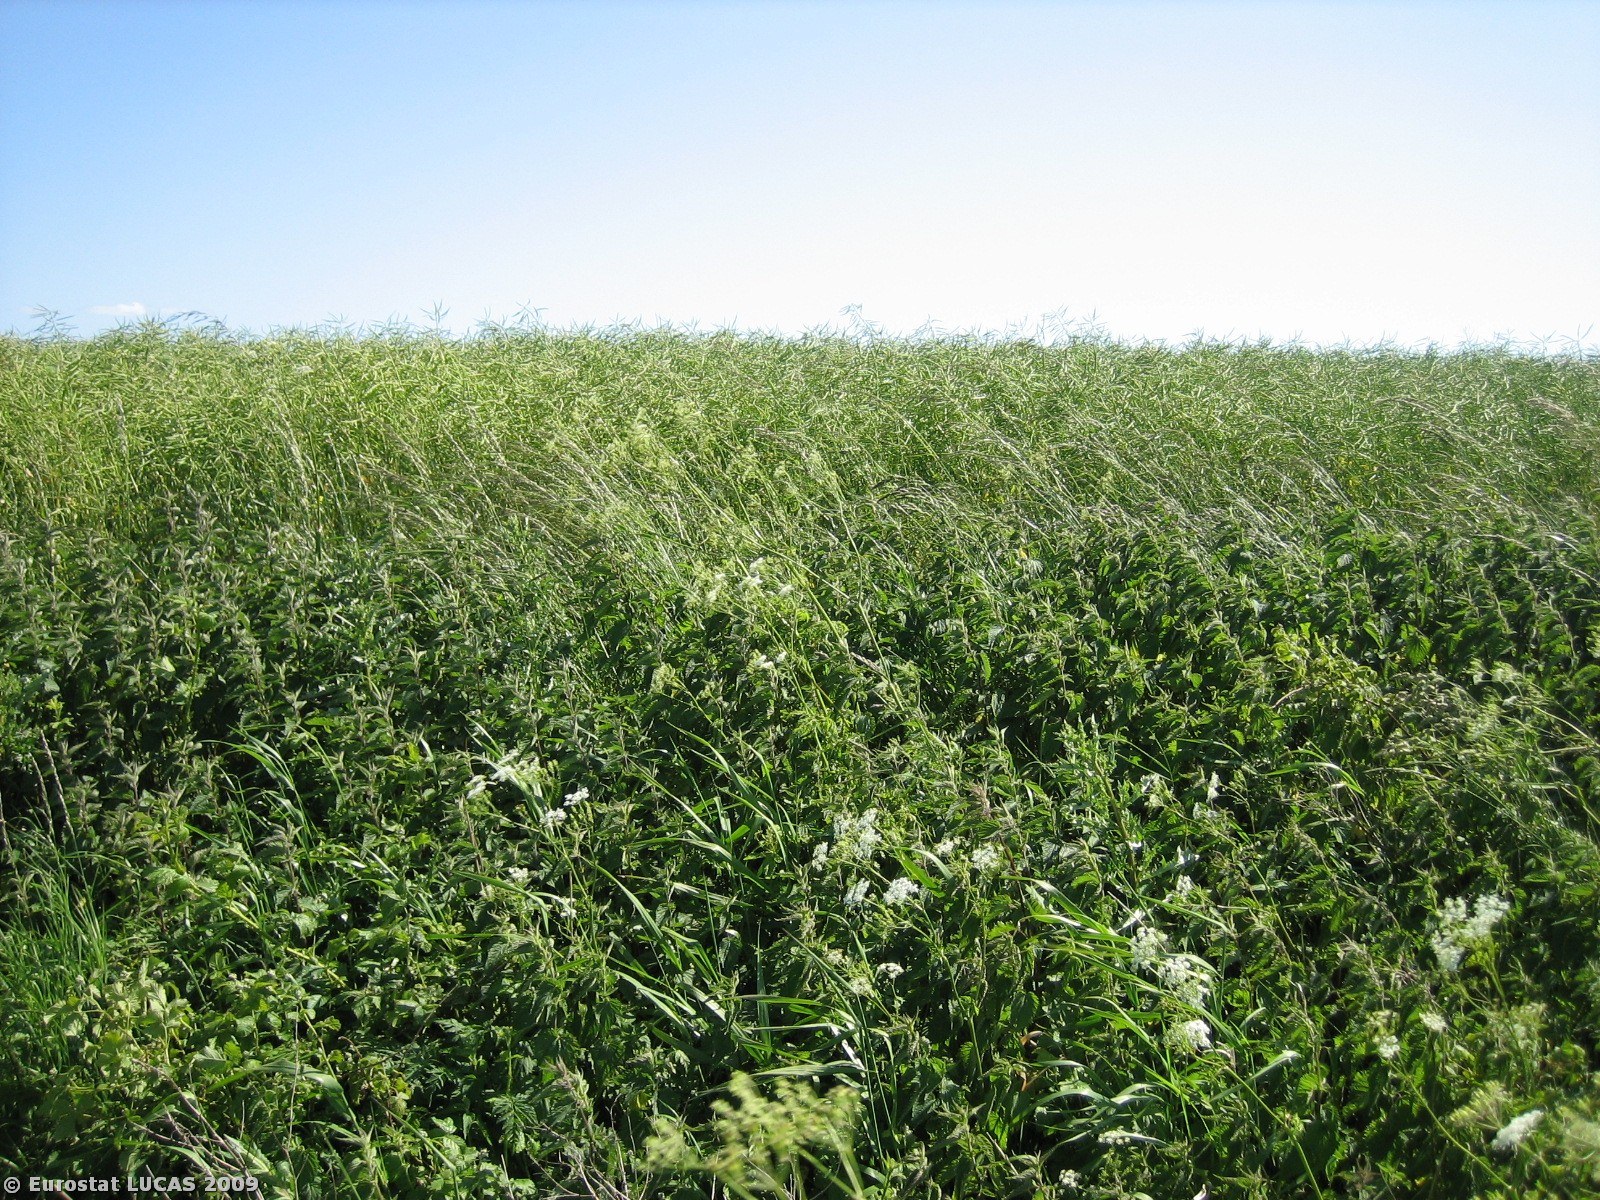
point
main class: Cropland
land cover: Rape and turnip rape
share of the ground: > 75 %
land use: Agriculture (excluding fallow land and kitchen gardens)
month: June
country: DK
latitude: 55.8998
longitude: 9.7284
